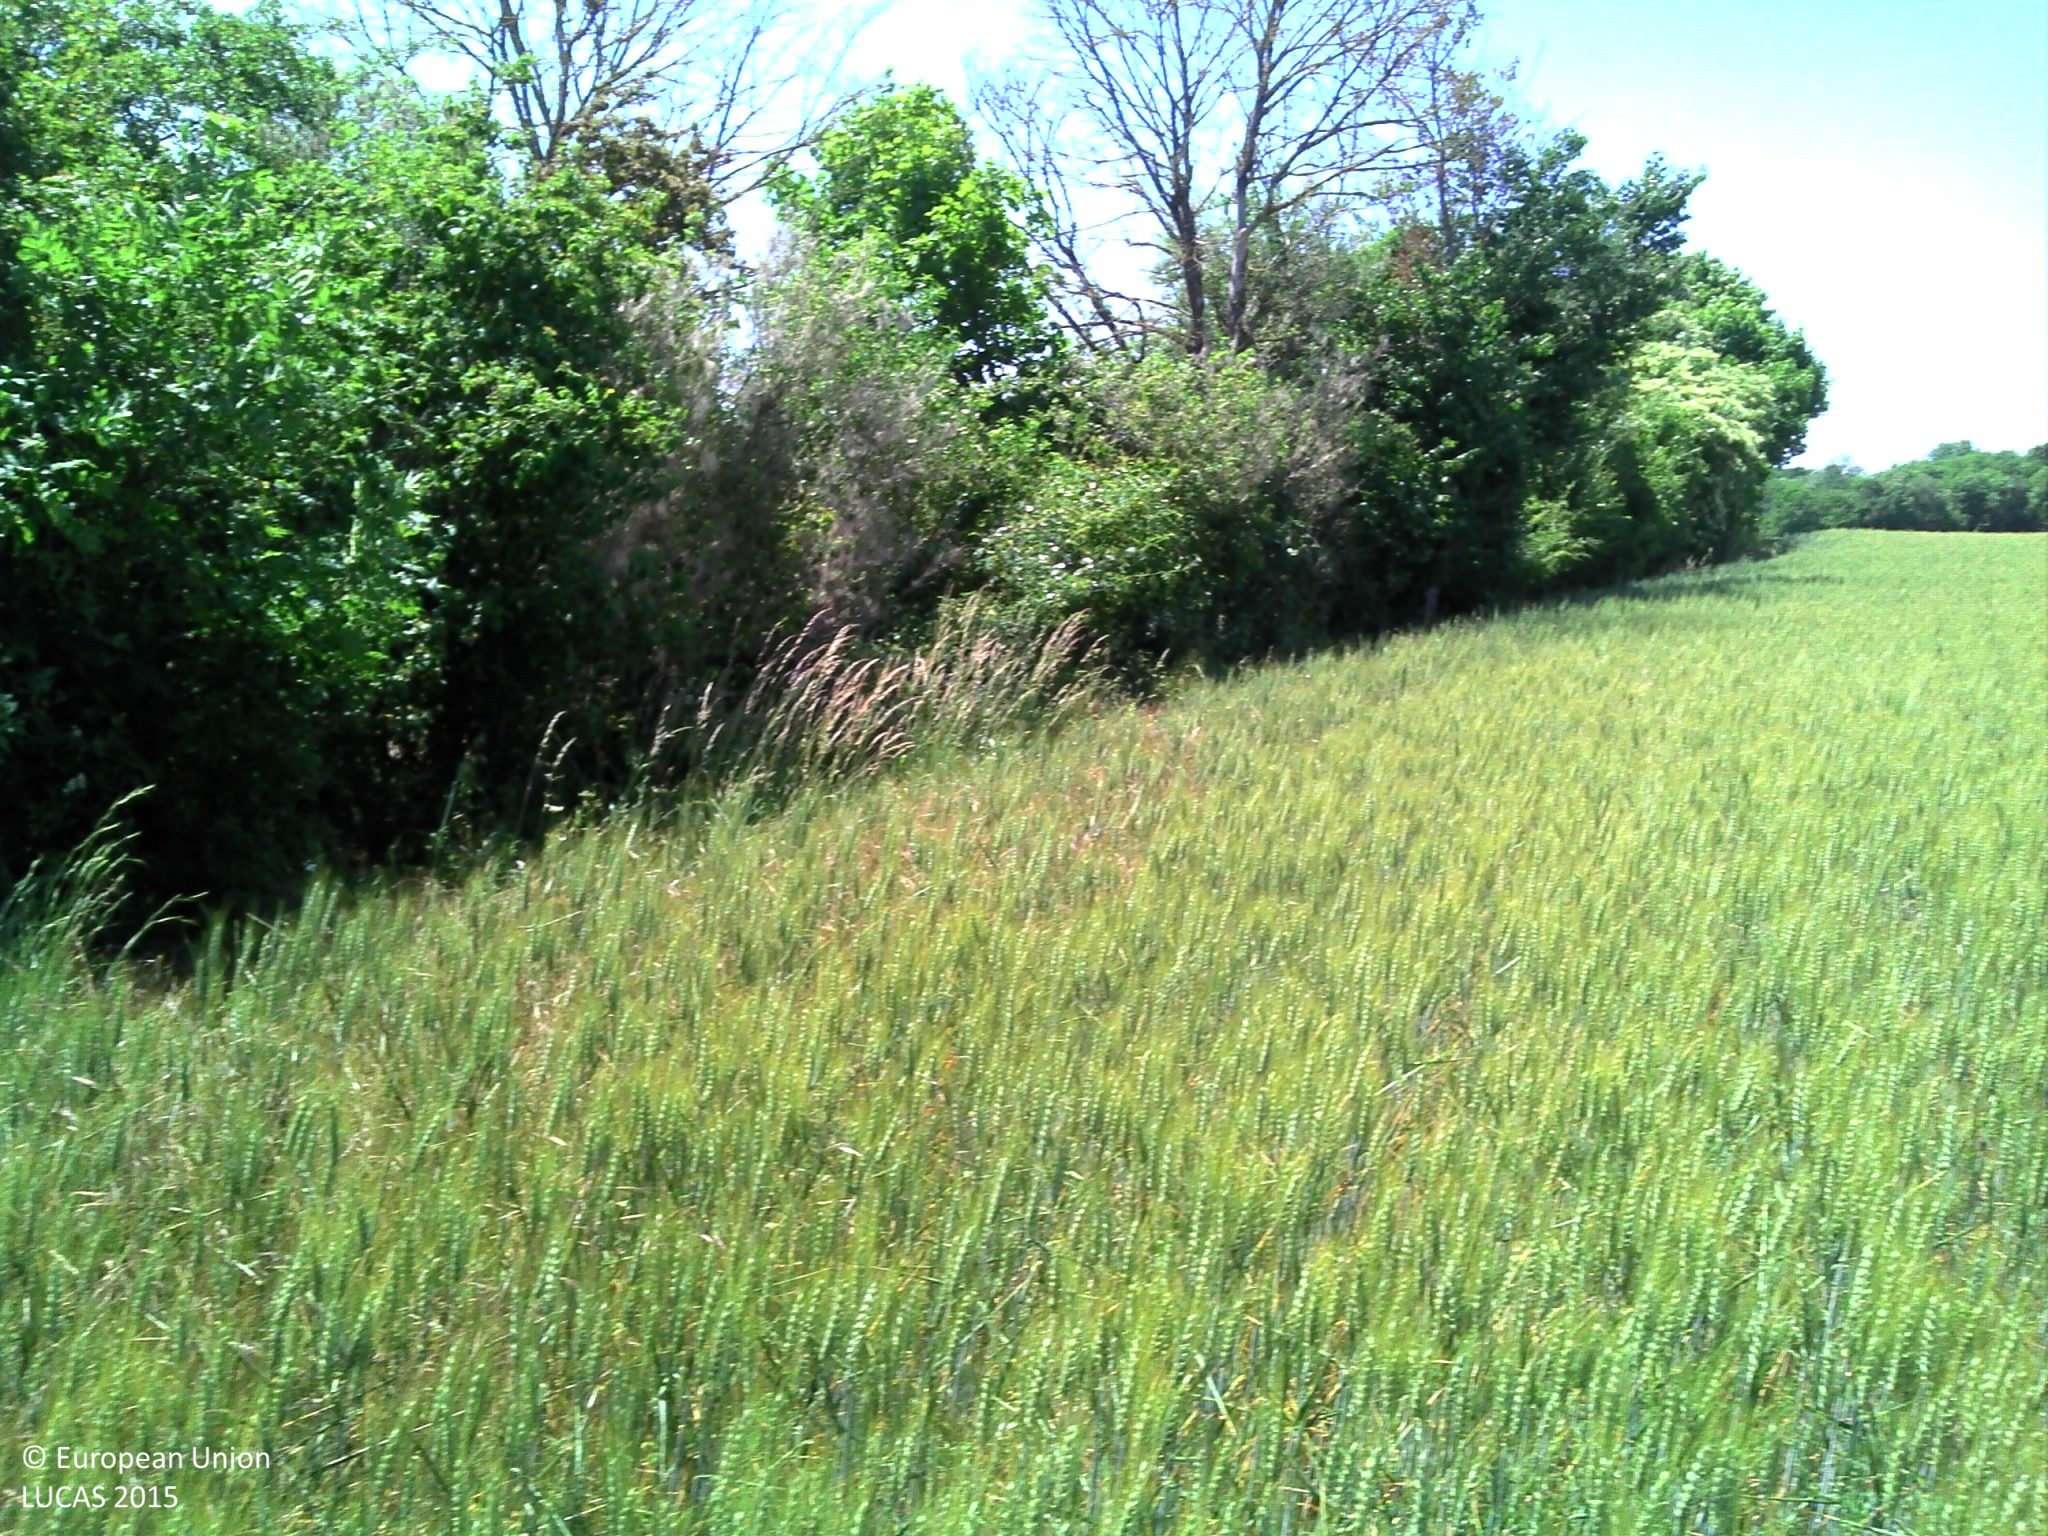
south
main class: Cropland
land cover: Common wheat
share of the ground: > 75 %
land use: Agriculture (excluding fallow land and kitchen gardens)
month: June
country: FR
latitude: 47.0410
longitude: 2.6898
